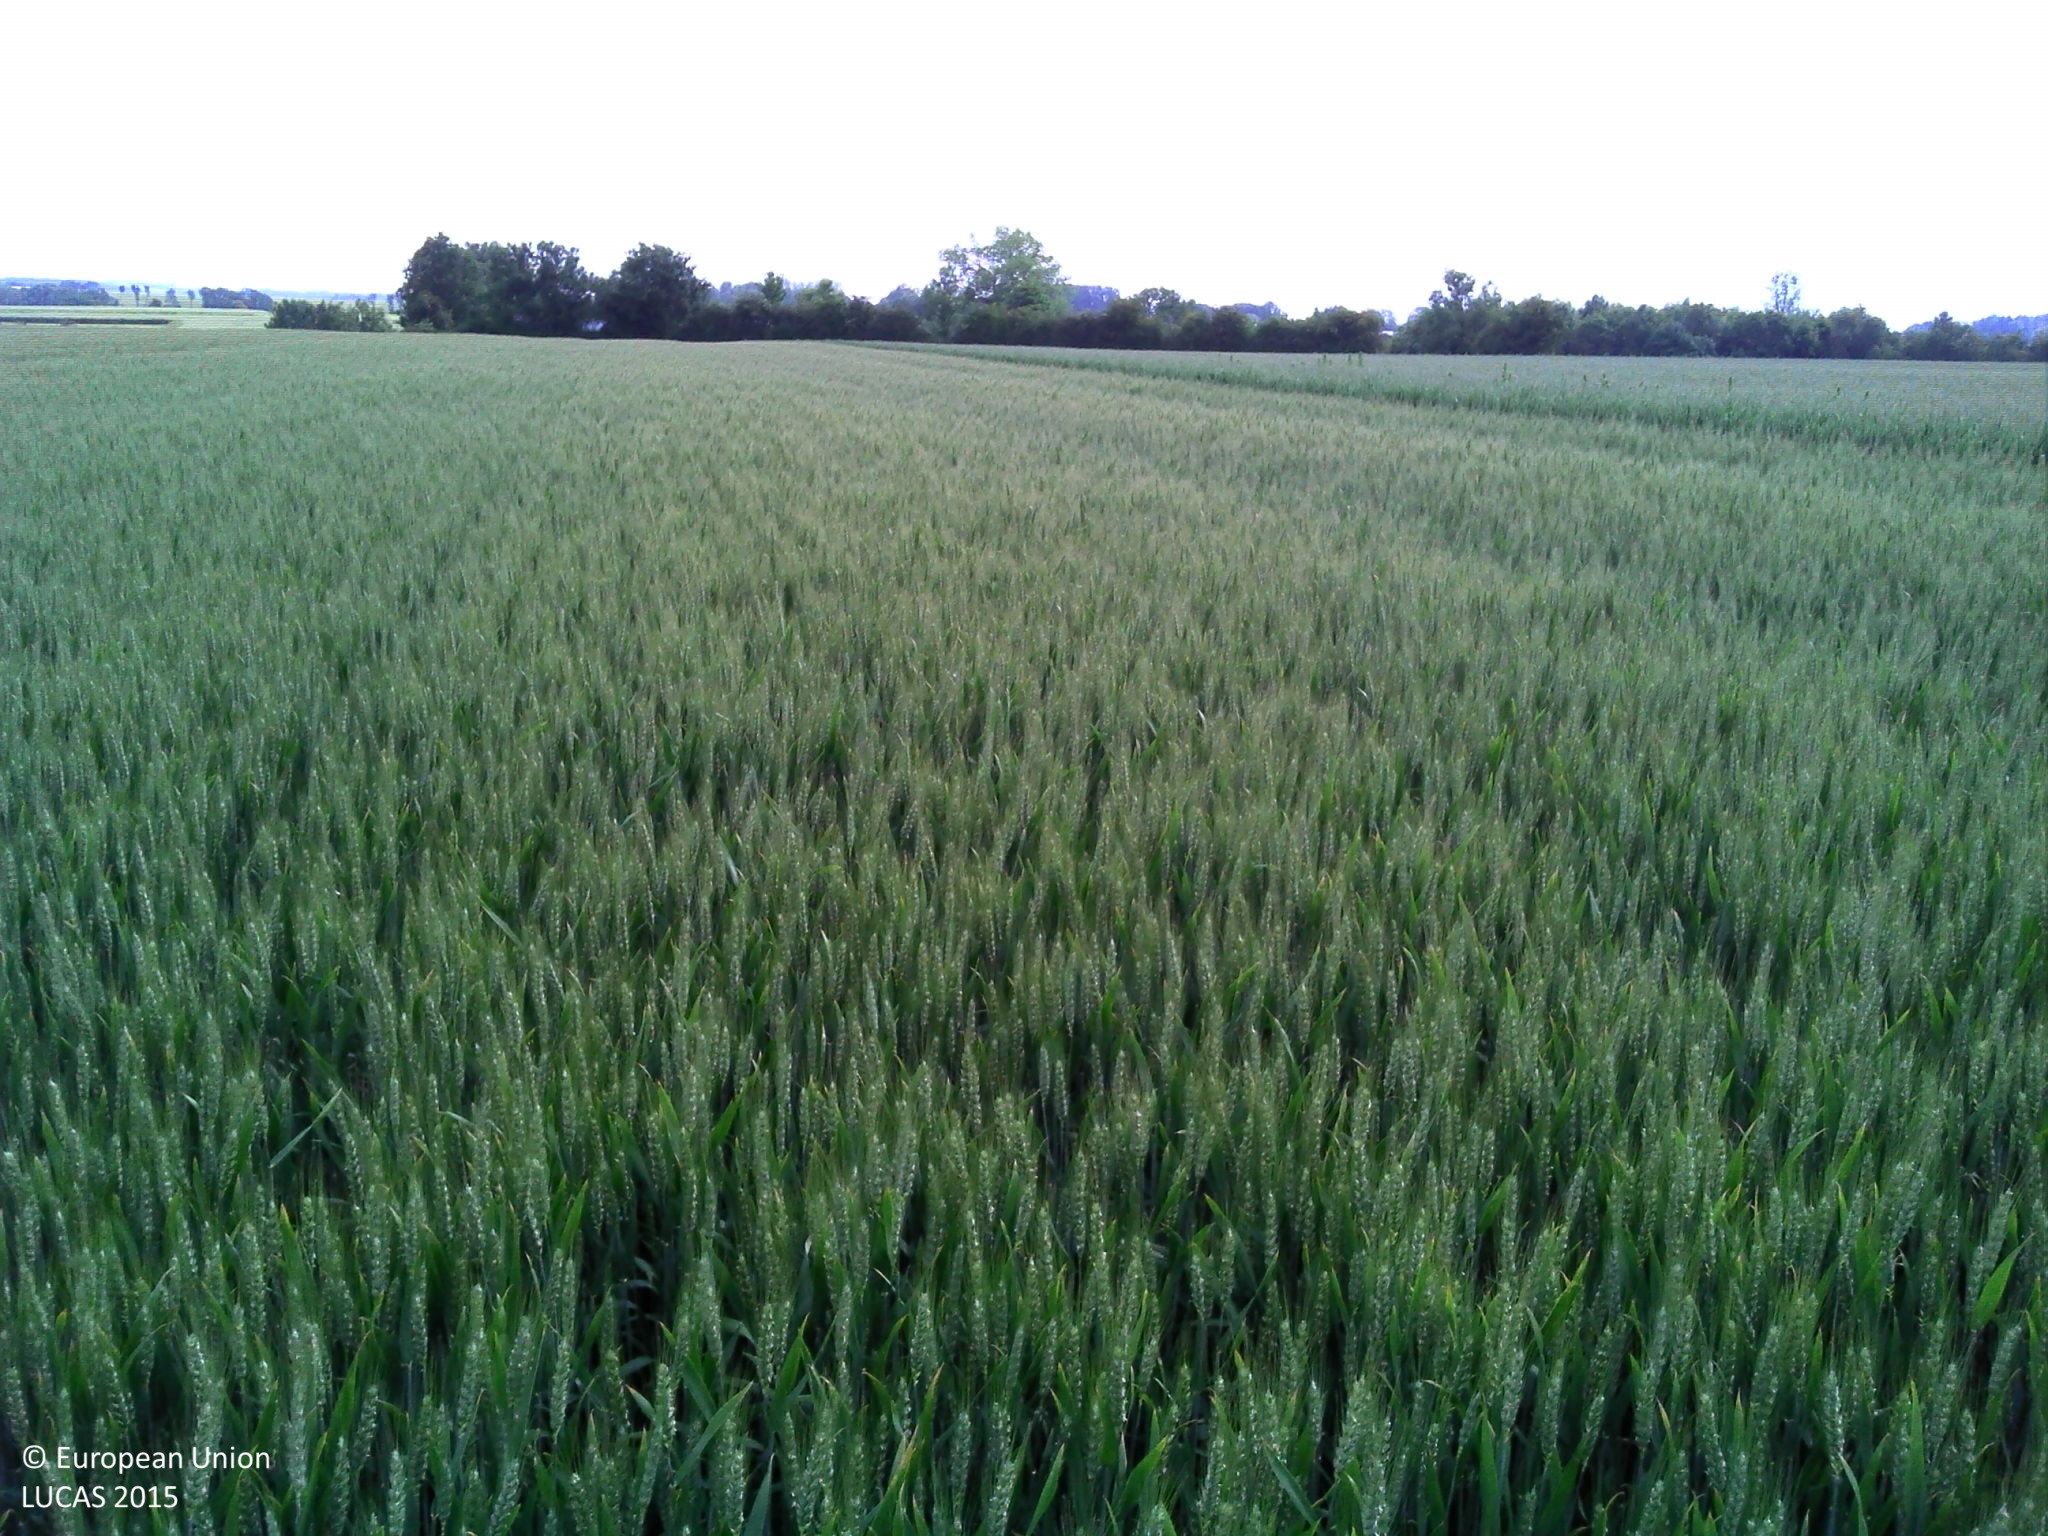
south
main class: Cropland
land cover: Common wheat
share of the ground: > 75 %
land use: Agriculture (excluding fallow land and kitchen gardens)
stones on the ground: 10 - 25 %
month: June
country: FR
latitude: 50.4877
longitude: 2.3613
